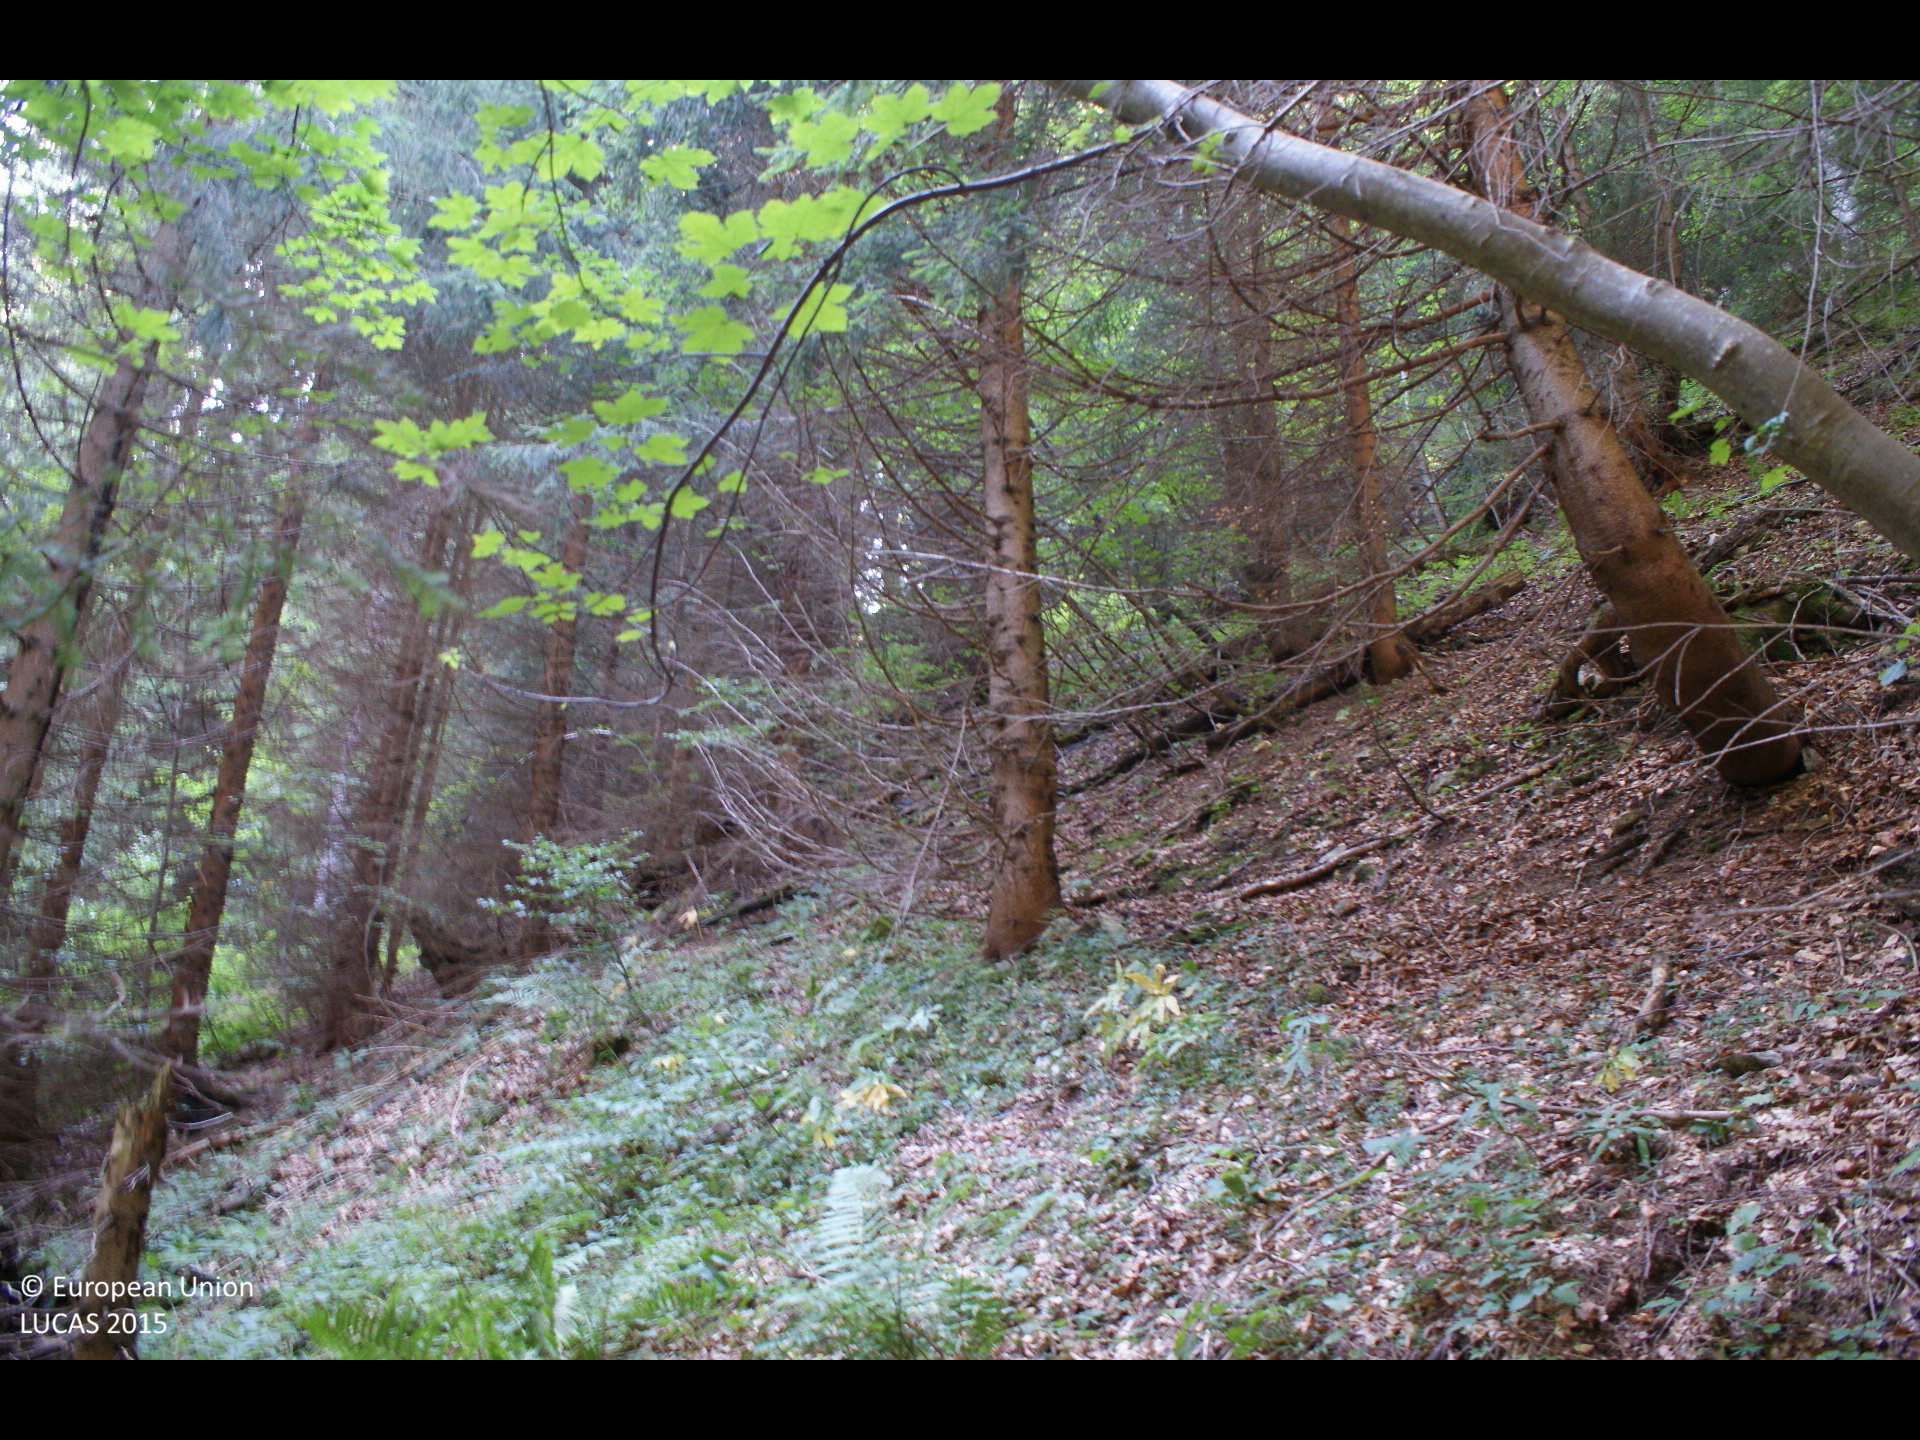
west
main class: Woodland
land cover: Spruce dominated mixed woodland
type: mountainous beech forest
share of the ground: > 75 %
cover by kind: coniferous forest trees 65 %, broadleaved forest trees 25 %, herbaceous plants 5 %, lichens and mosses 5 %
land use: Forestry
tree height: > 5 m
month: August
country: AT
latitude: 47.6228
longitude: 15.3899
